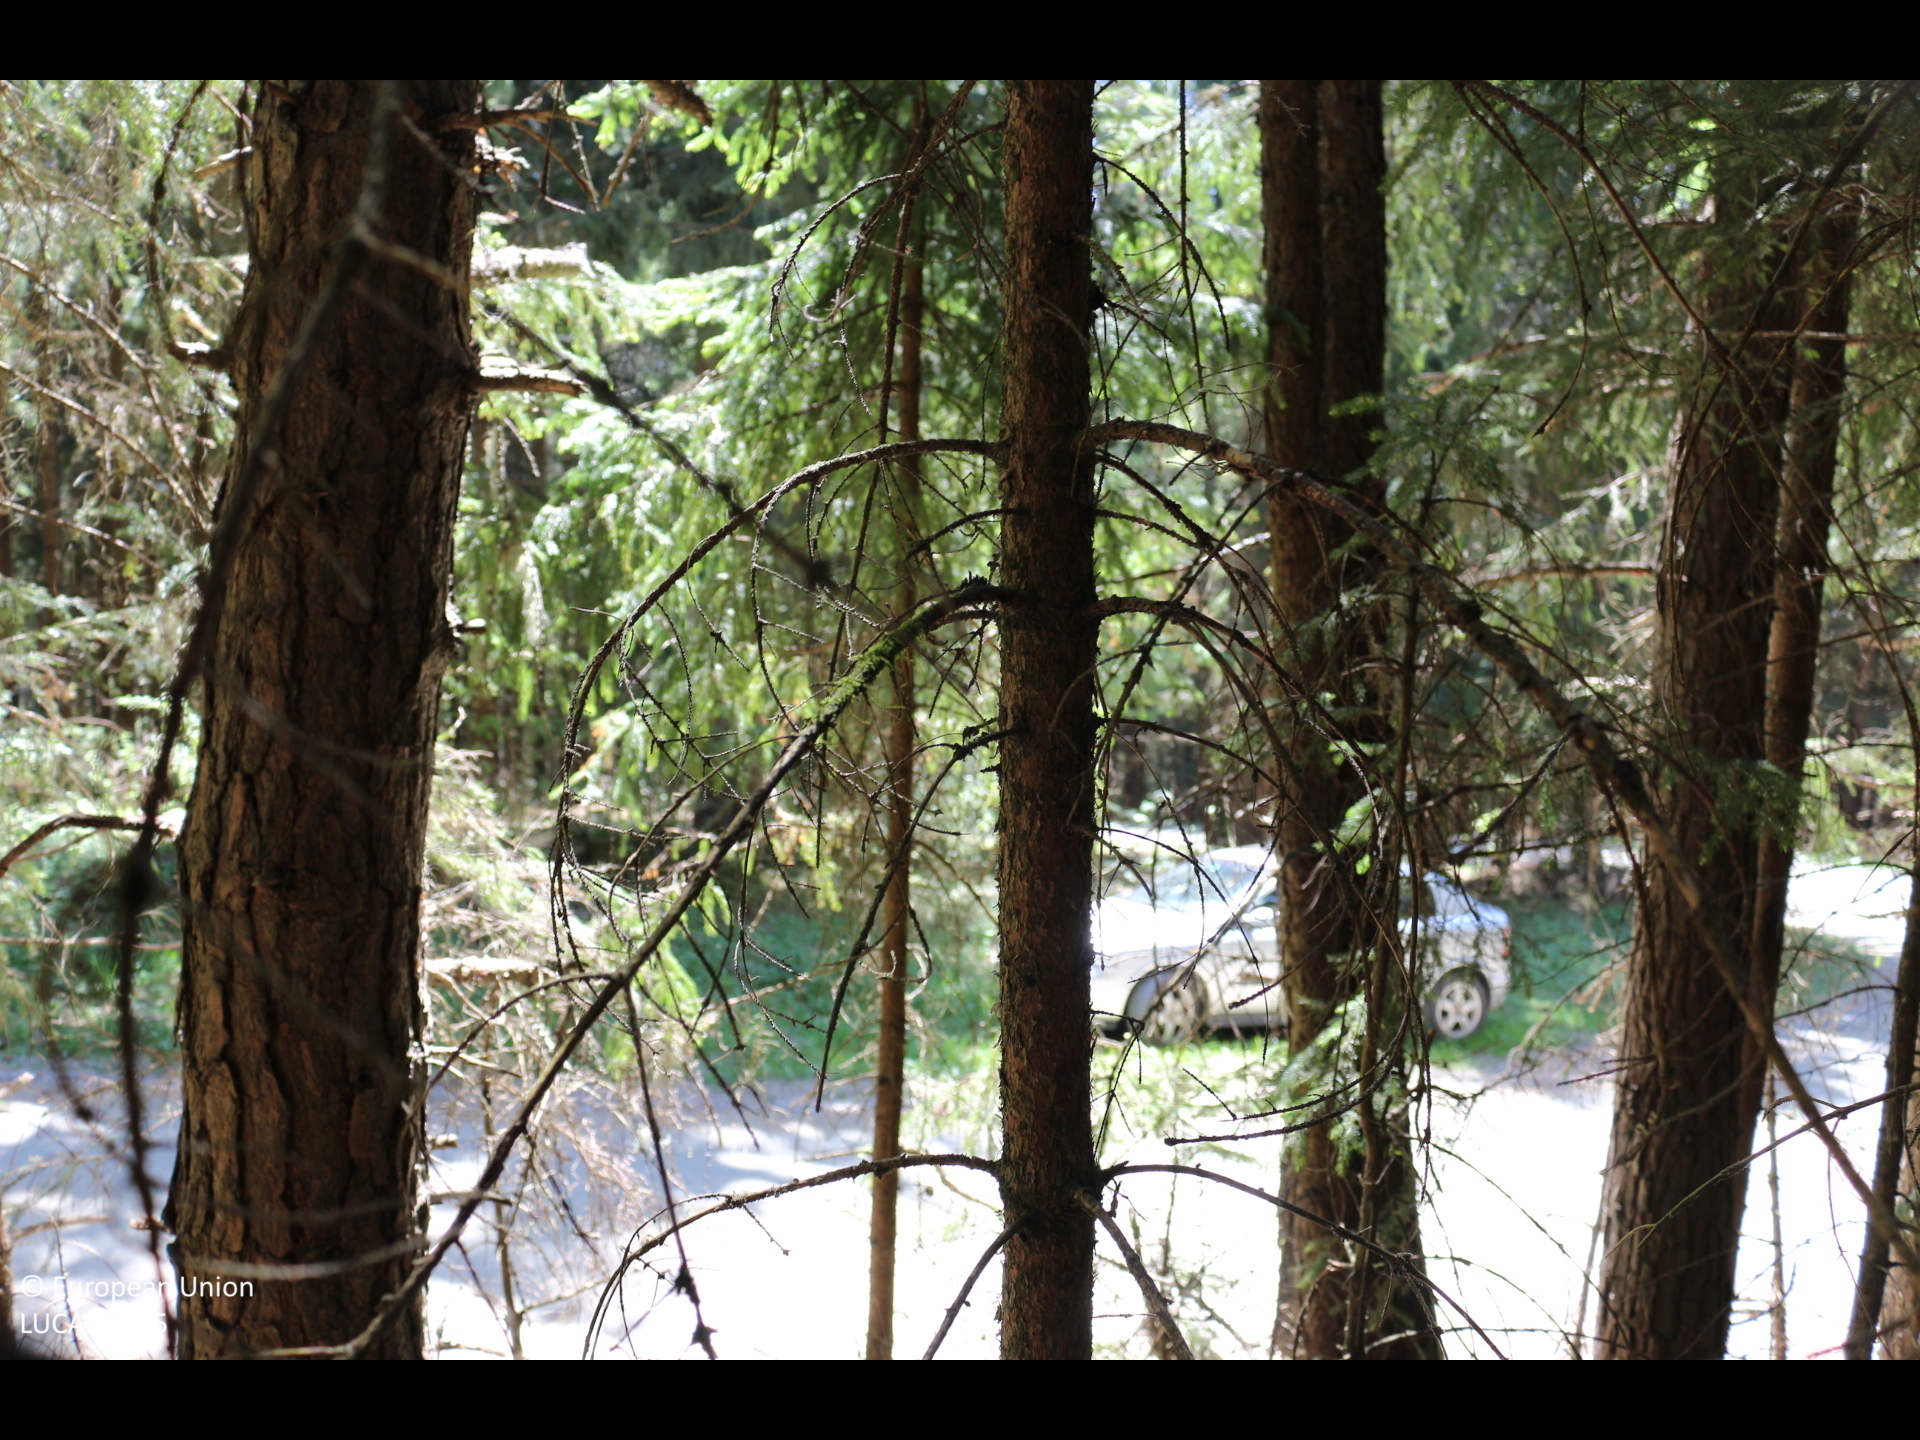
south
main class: Woodland
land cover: Spruce dominated coniferous woodland
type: alpine coniferous forest
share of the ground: > 75 %
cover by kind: coniferous forest trees 100 %
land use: Forestry
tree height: > 5 m
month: May
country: AT
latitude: 46.8065
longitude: 14.2828
